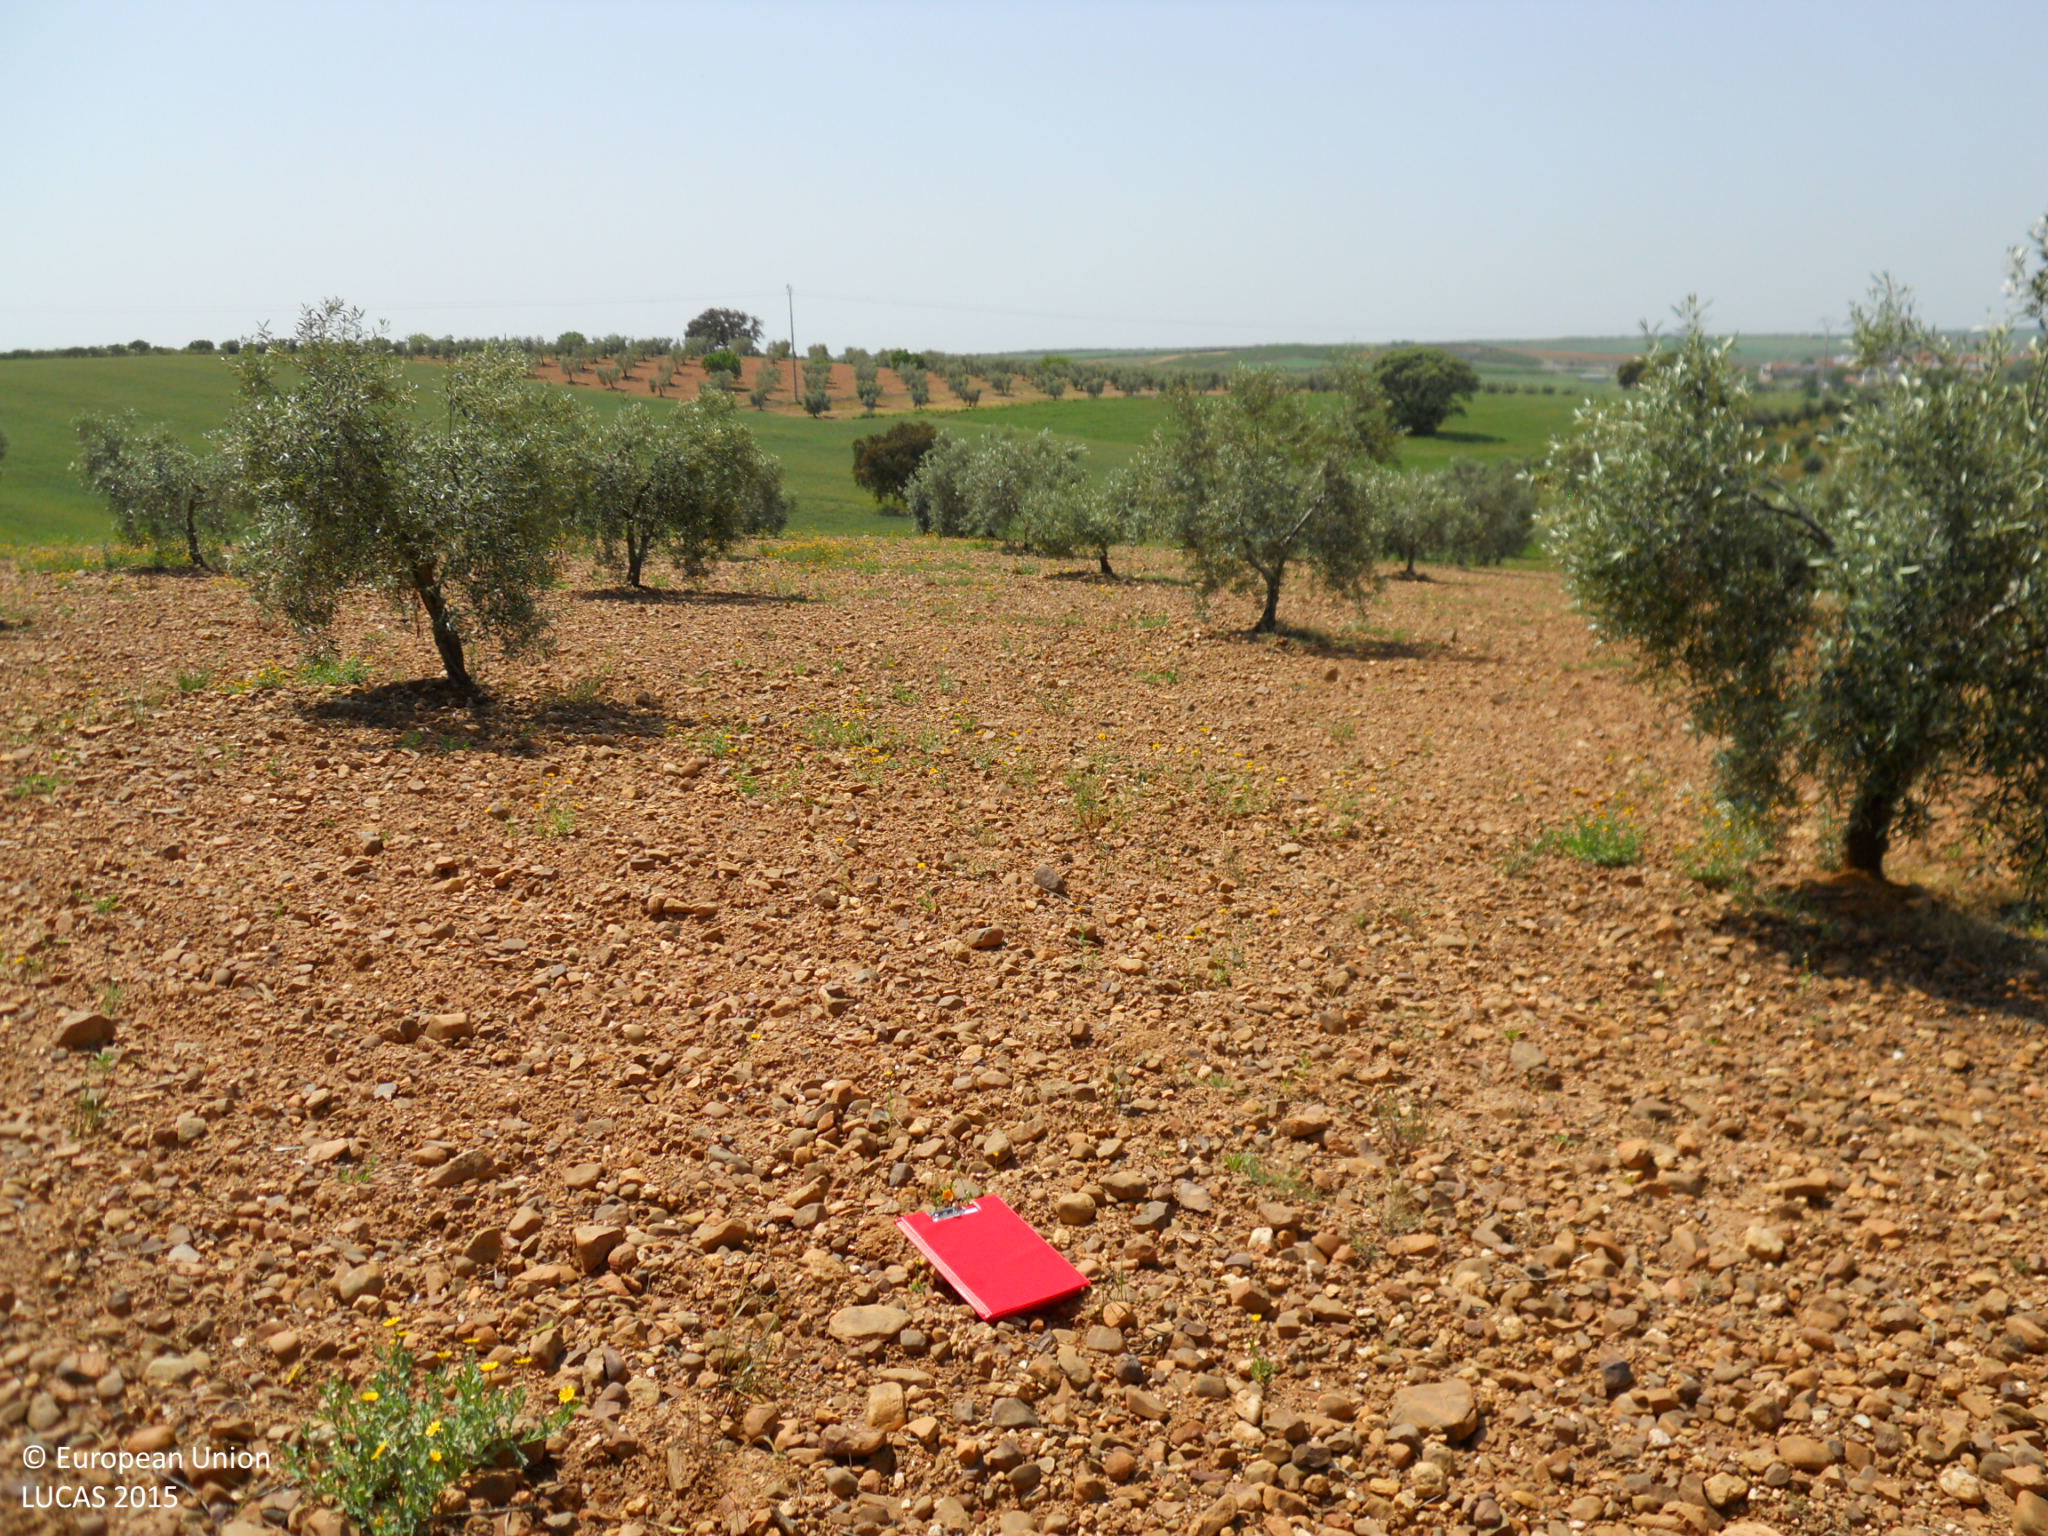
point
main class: Cropland
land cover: Olive groves
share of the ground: 10 - 25 %
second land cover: Other bare soil
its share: > 75 %
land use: Agriculture (excluding fallow land and kitchen gardens)
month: April
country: ES
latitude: 39.0645
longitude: -6.4859
